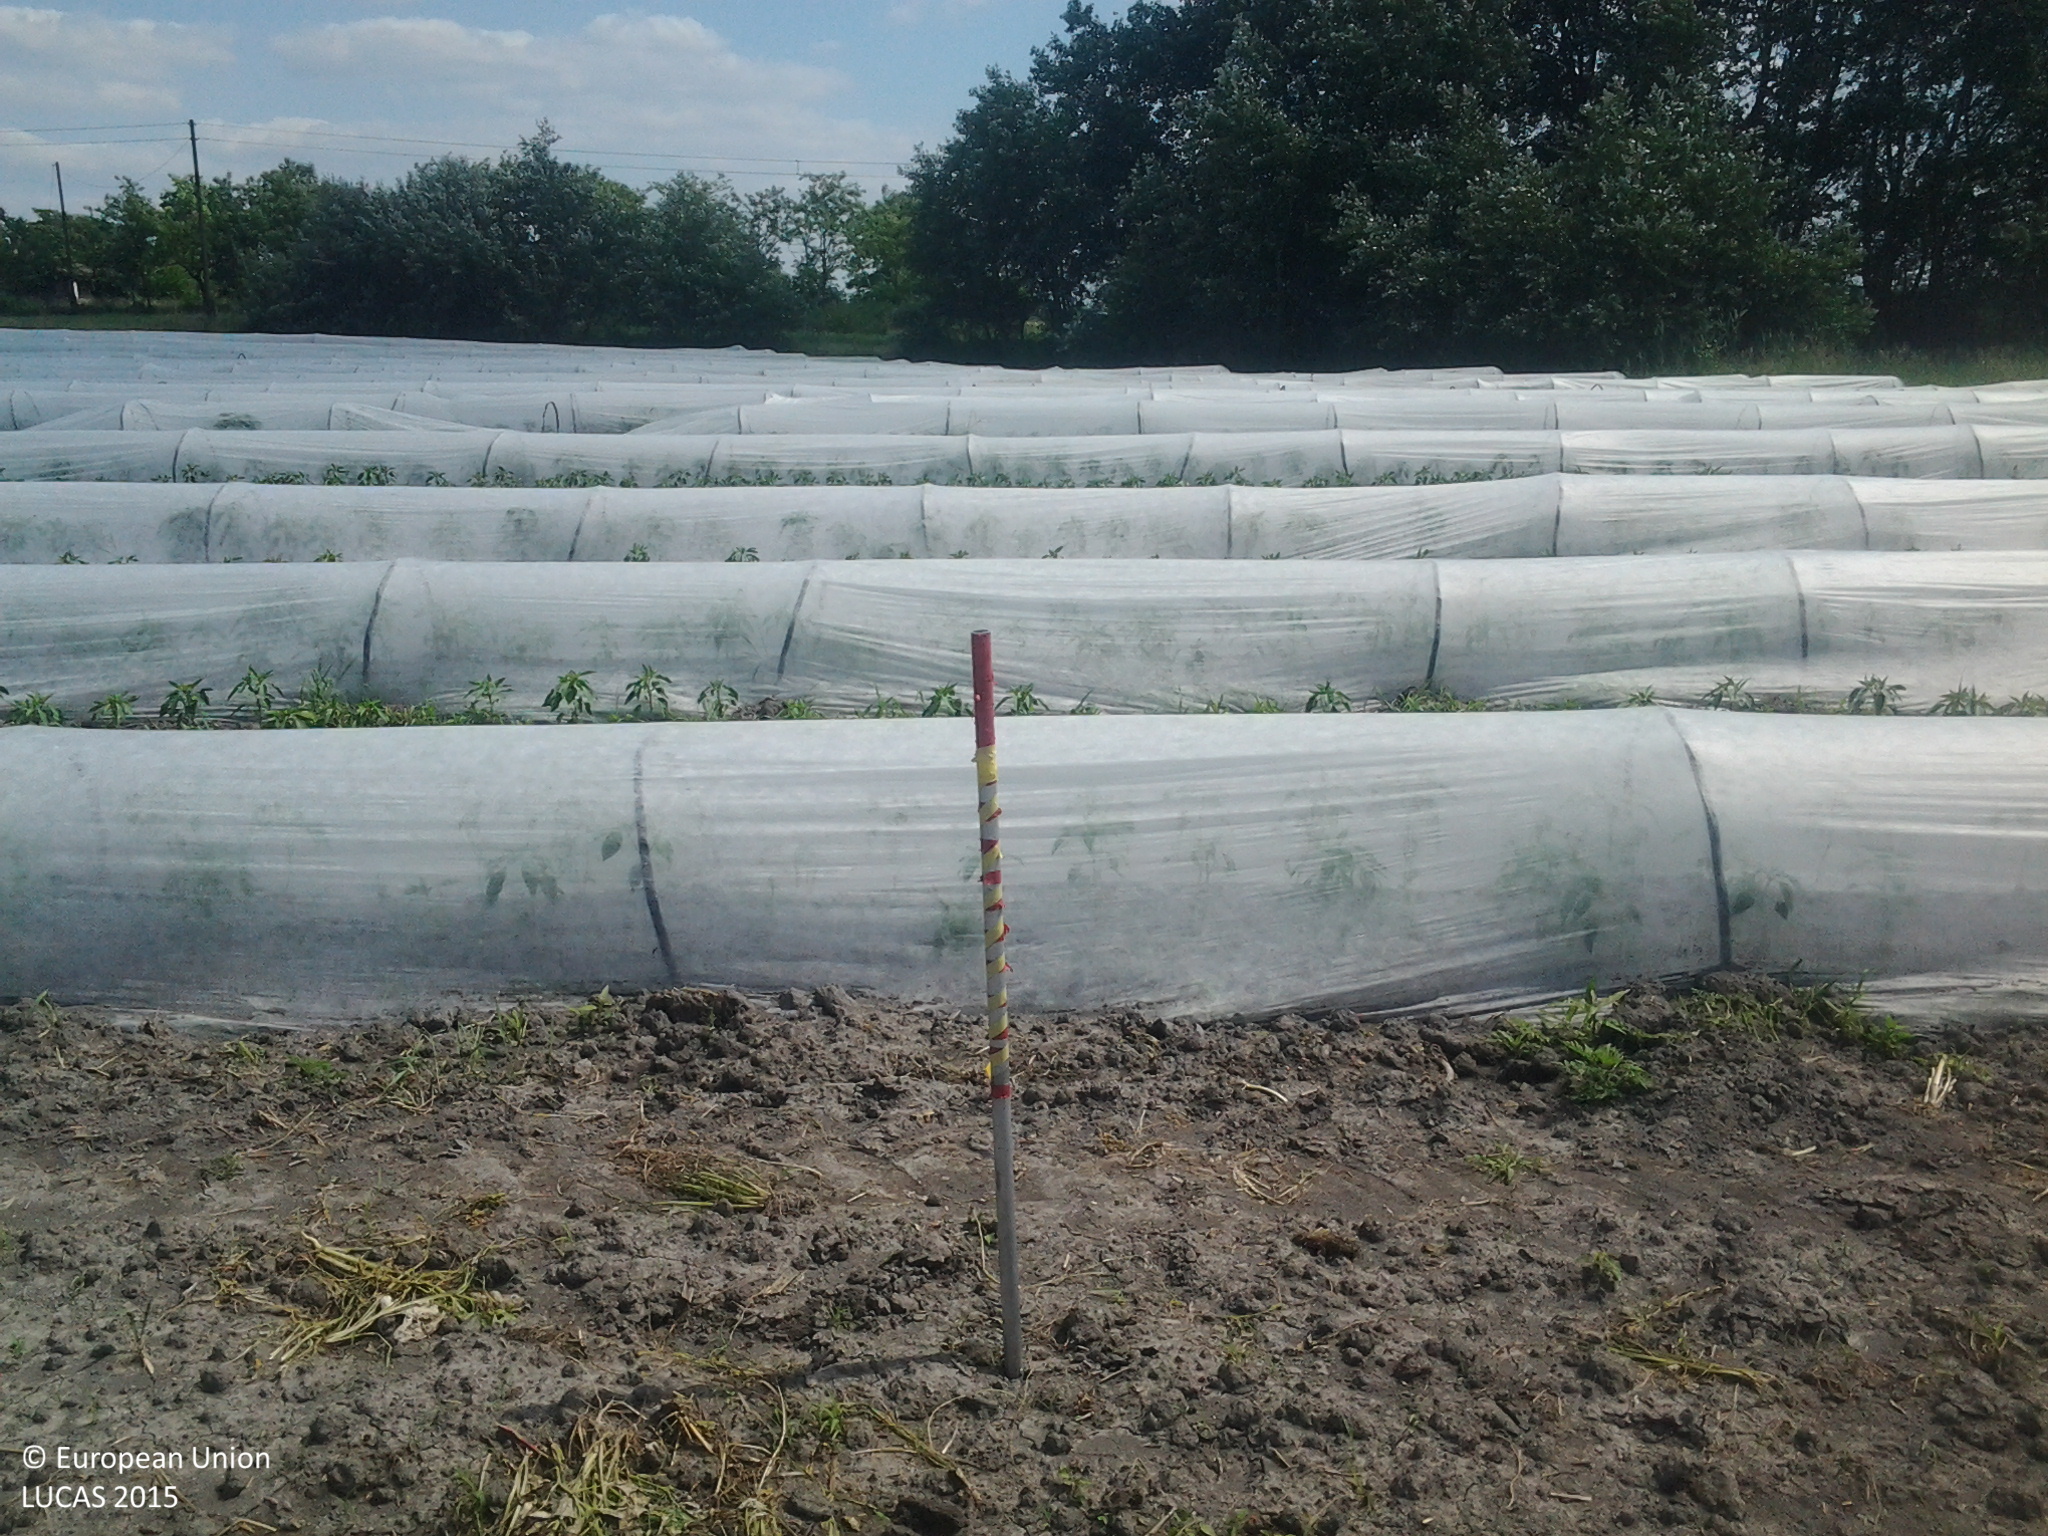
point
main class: Cropland
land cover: Other fresh vegetables
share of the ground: 50 - 75 %
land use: Agriculture (excluding fallow land and kitchen gardens)
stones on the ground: < 10 %
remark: Tilled/Sowed
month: June
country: HU
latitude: 46.9594
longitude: 19.3086
